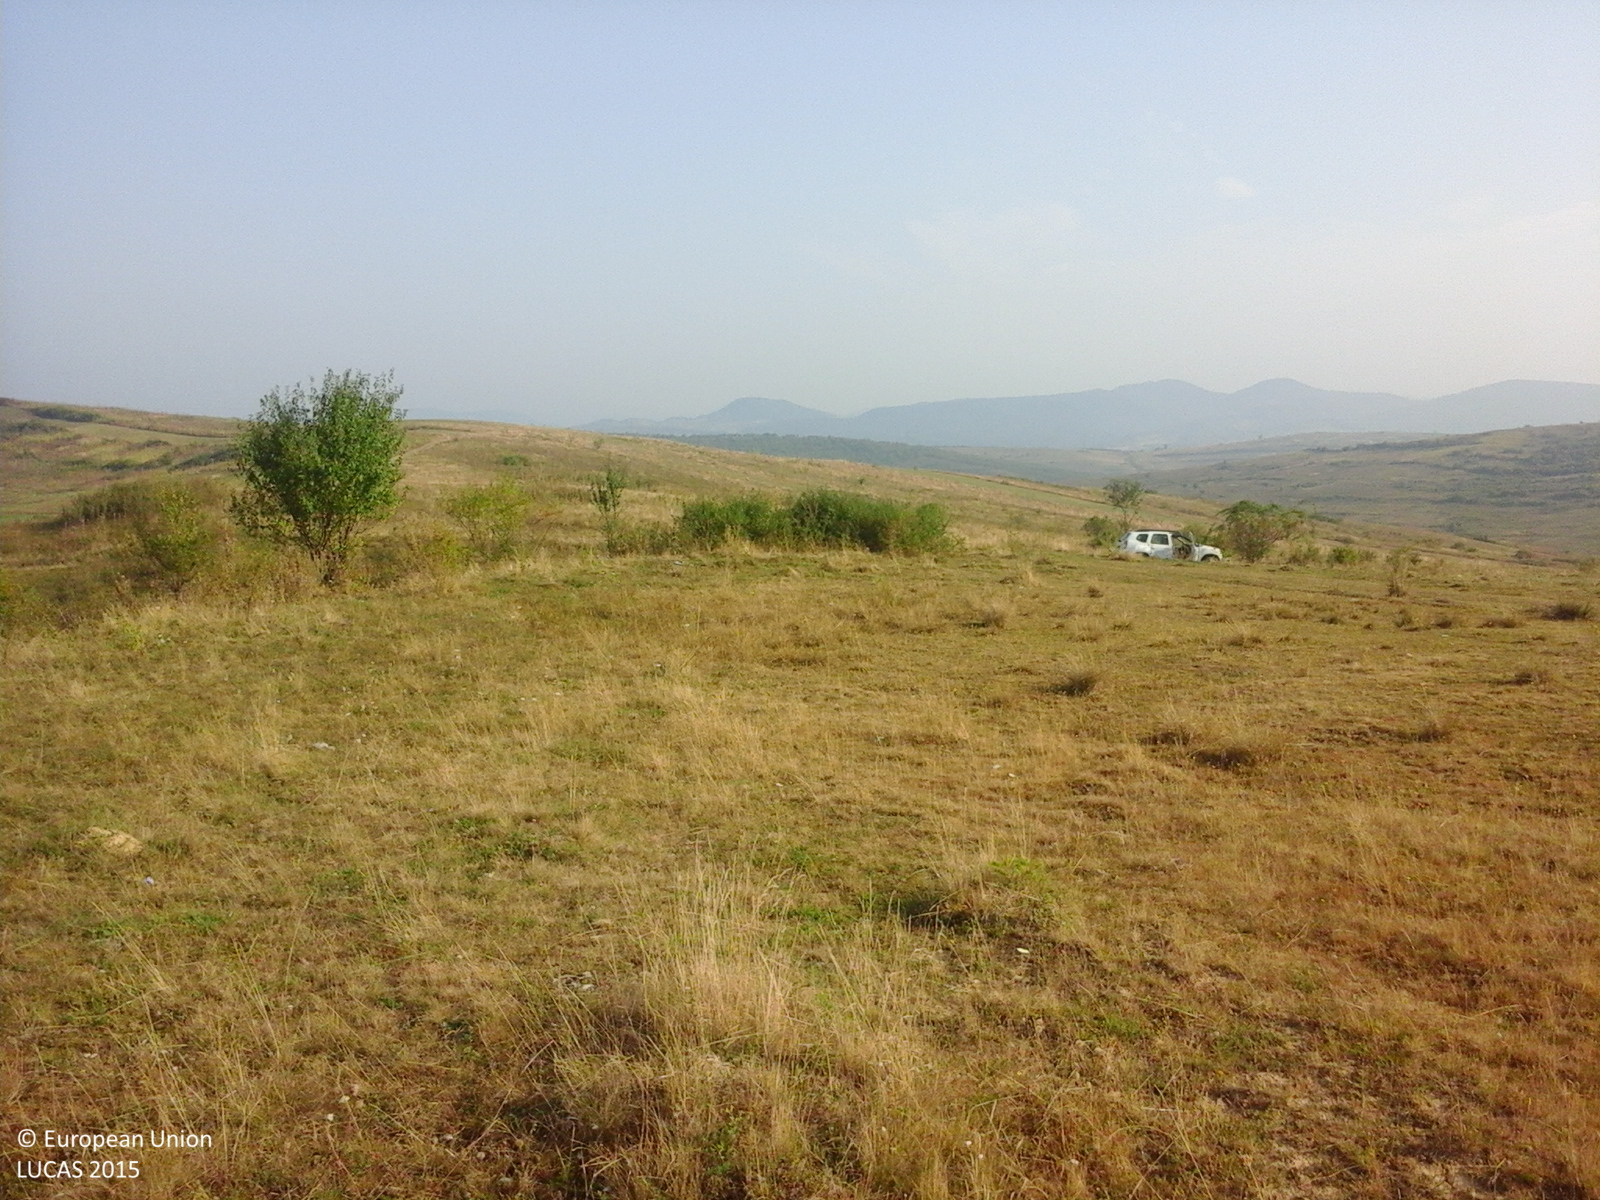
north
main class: Grassland
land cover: Grassland without tree/shrub cover
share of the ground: > 75 %
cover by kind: herbaceous plants 100 %
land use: Agriculture (excluding fallow land and kitchen gardens)
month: September
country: RO
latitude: 47.2076
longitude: 24.3333
